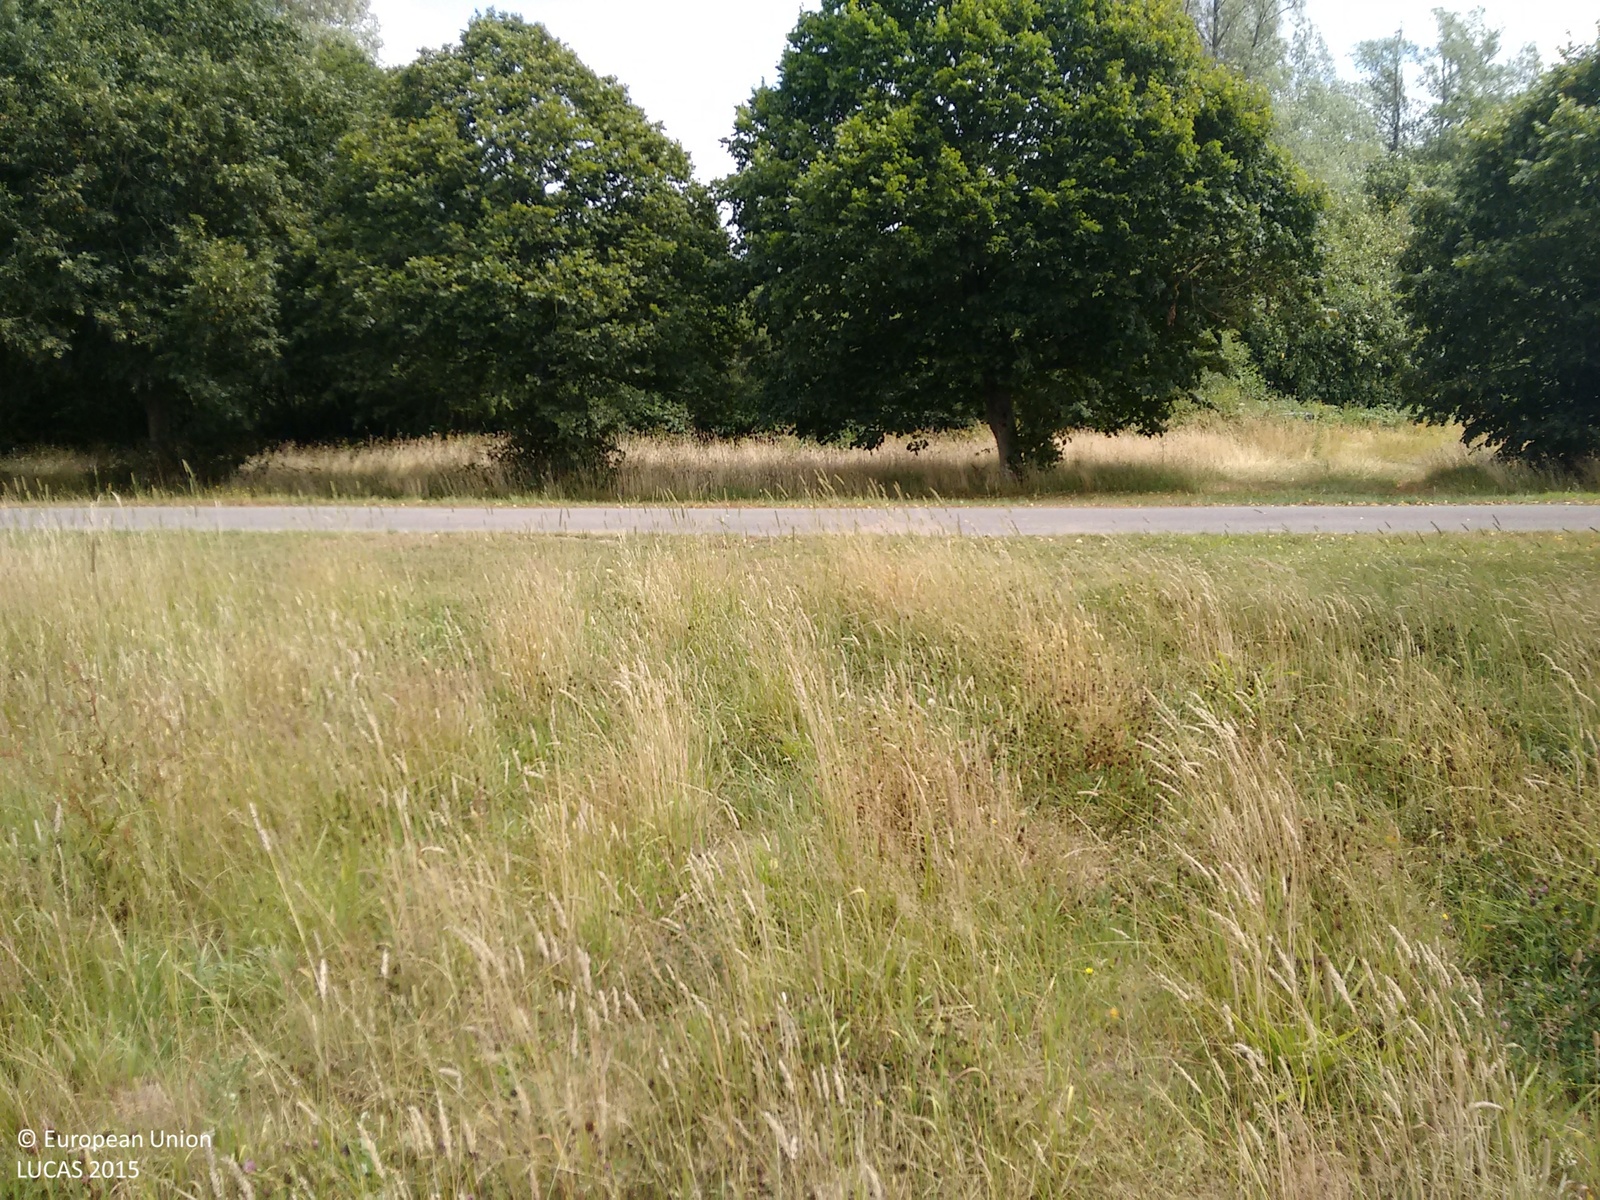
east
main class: Grassland
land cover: Grassland without tree/shrub cover
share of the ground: > 75 %
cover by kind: herbaceous plants 100 %
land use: Agriculture (excluding fallow land and kitchen gardens)
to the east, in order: Grassland without tree/shrub cover; Paved roads, cycling and walking lanes; Grass margins; Lines of trees; Grass margins; Broadleaved woodland; Inland fresh water bodies; Broadleaved woodland; Inland fresh water bodies; Broadleaved woodland; Fences; Grassland without tree/shrub cover; Fences; Other leguminous and mixtures for fodder; Fences; Broadleaved woodland
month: July
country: GB
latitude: 51.1169
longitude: -0.4521
